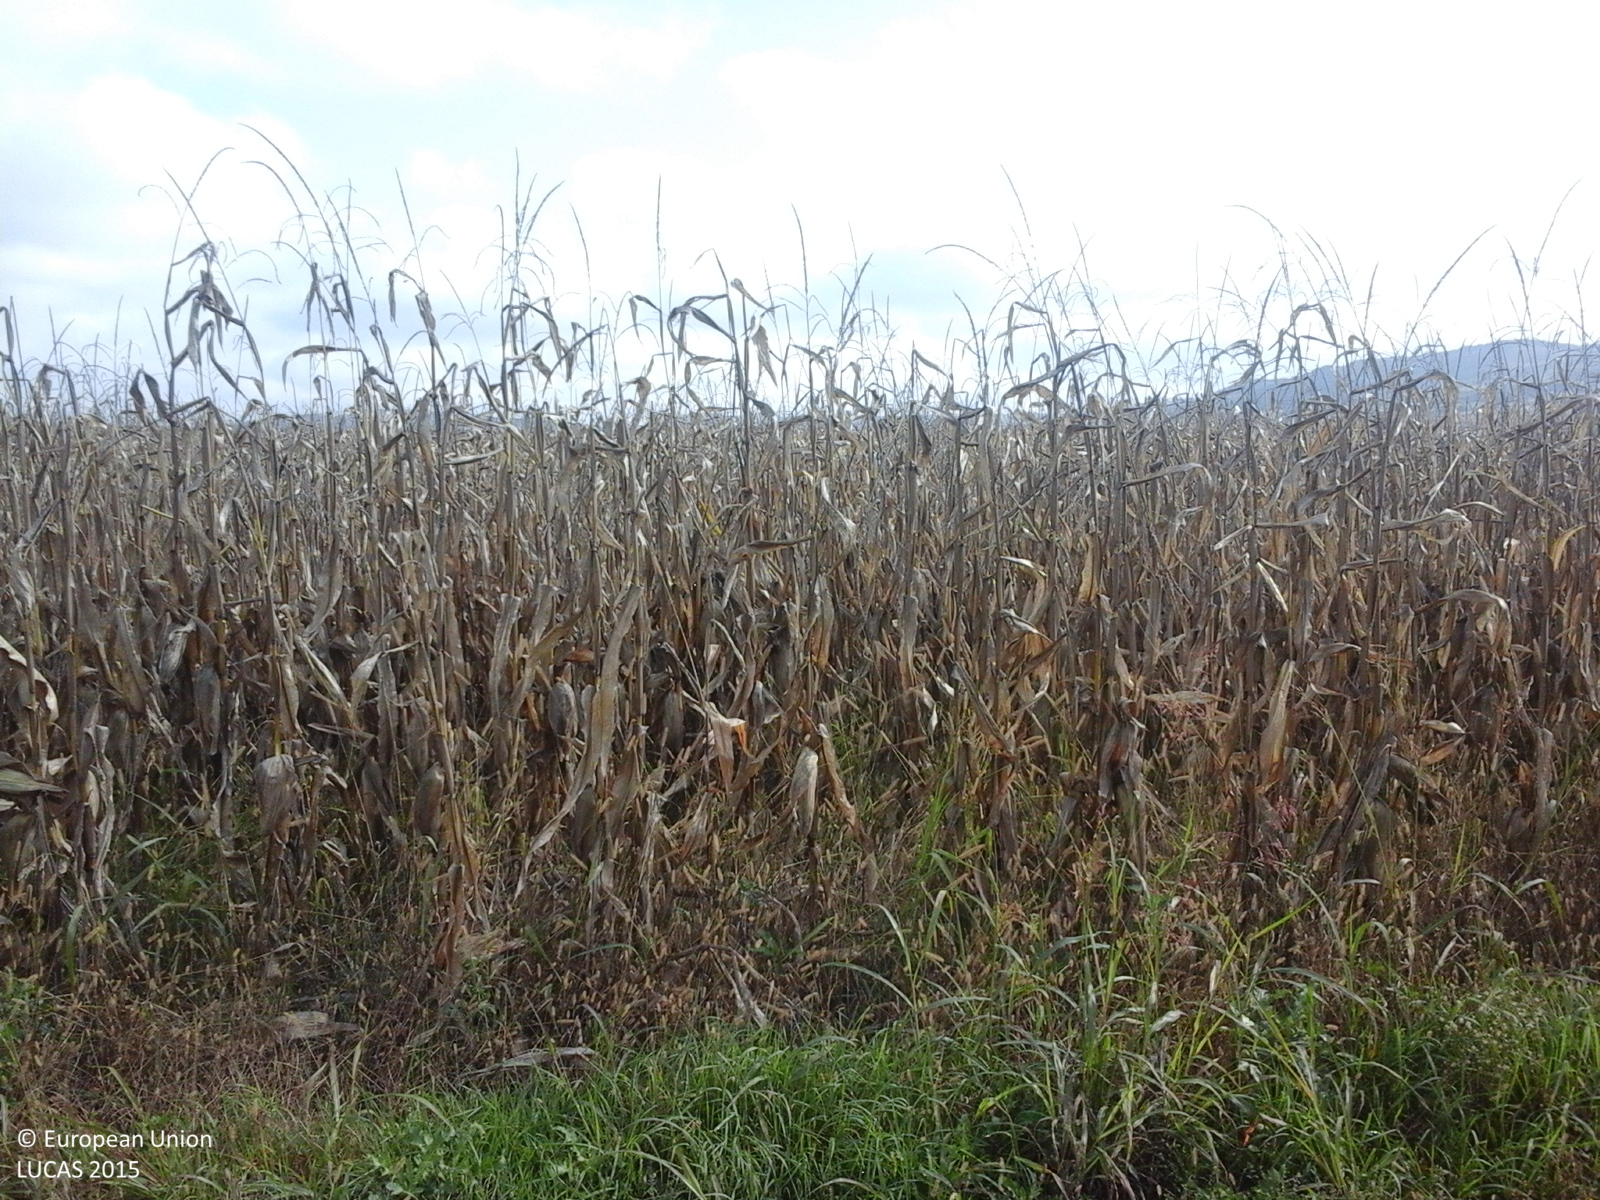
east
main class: Cropland
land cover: Maize
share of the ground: > 75 %
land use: Agriculture (excluding fallow land and kitchen gardens)
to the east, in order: Maize; Grass margins; Tracks; Grass margins; Maize
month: October
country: RO
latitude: 46.4170
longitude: 23.9577
